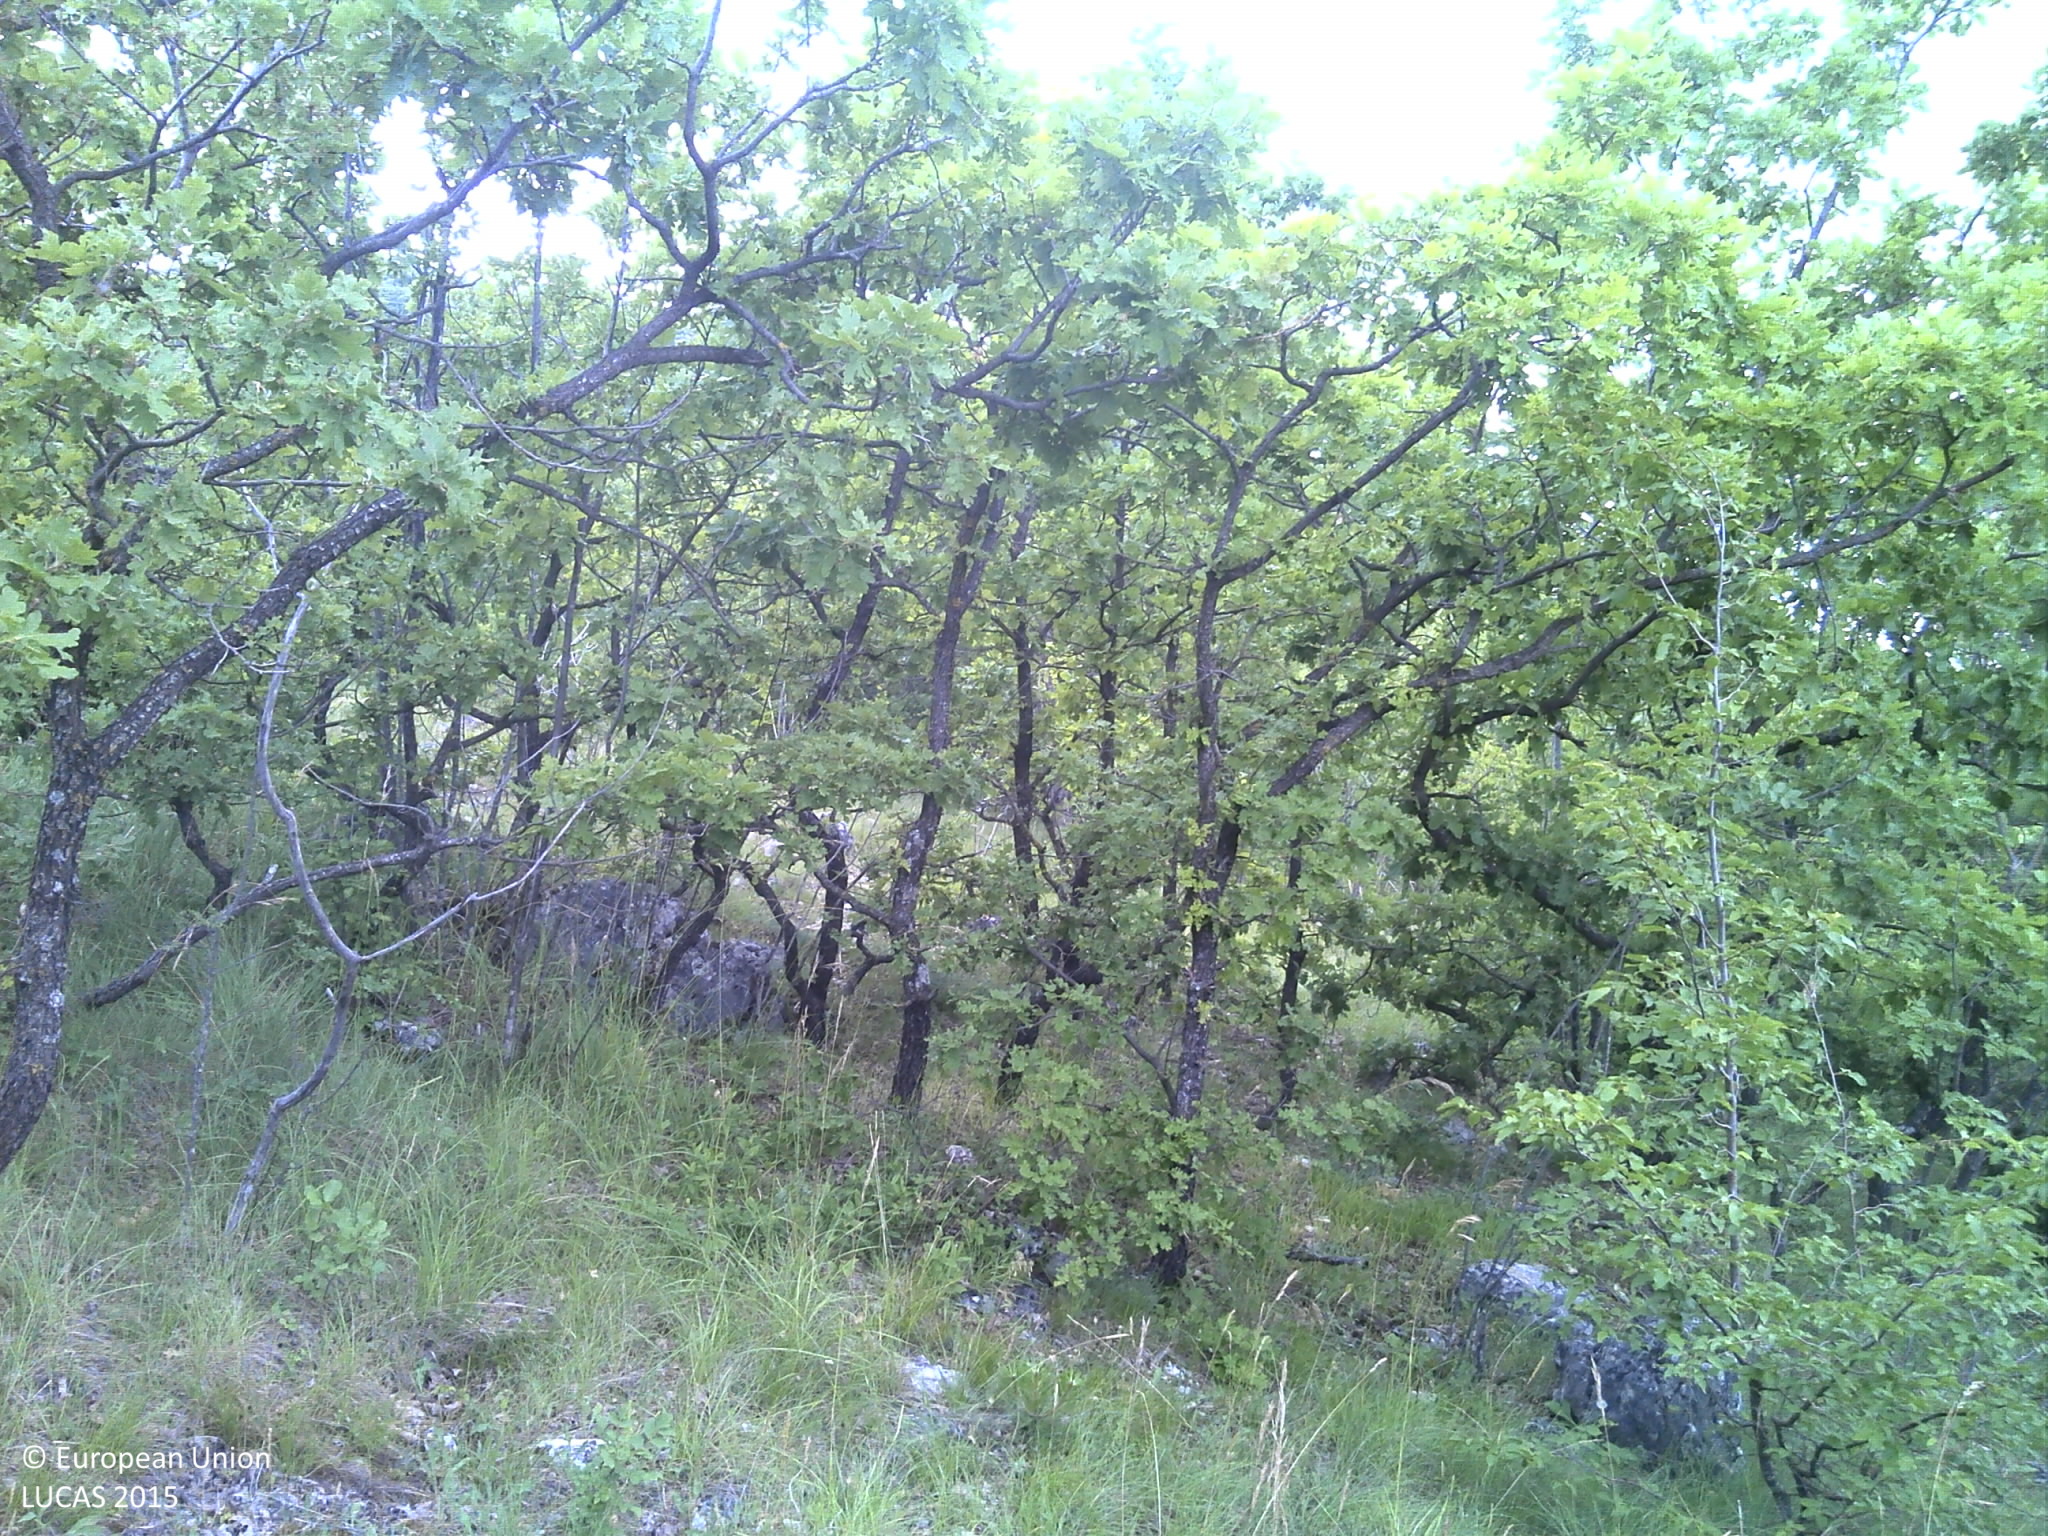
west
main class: Woodland
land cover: Broadleaved woodland
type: thermophilous deciduous forest
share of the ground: 50 - 75 %
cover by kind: broadleaved forest trees 65 %, herbaceous plants 15 %, coniferous forest trees 10 %, consolidated bare surface 10 %
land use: Semi-natural and natural areas not in use
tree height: > 5 m
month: June
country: HR
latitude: 43.5846
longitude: 16.5180
